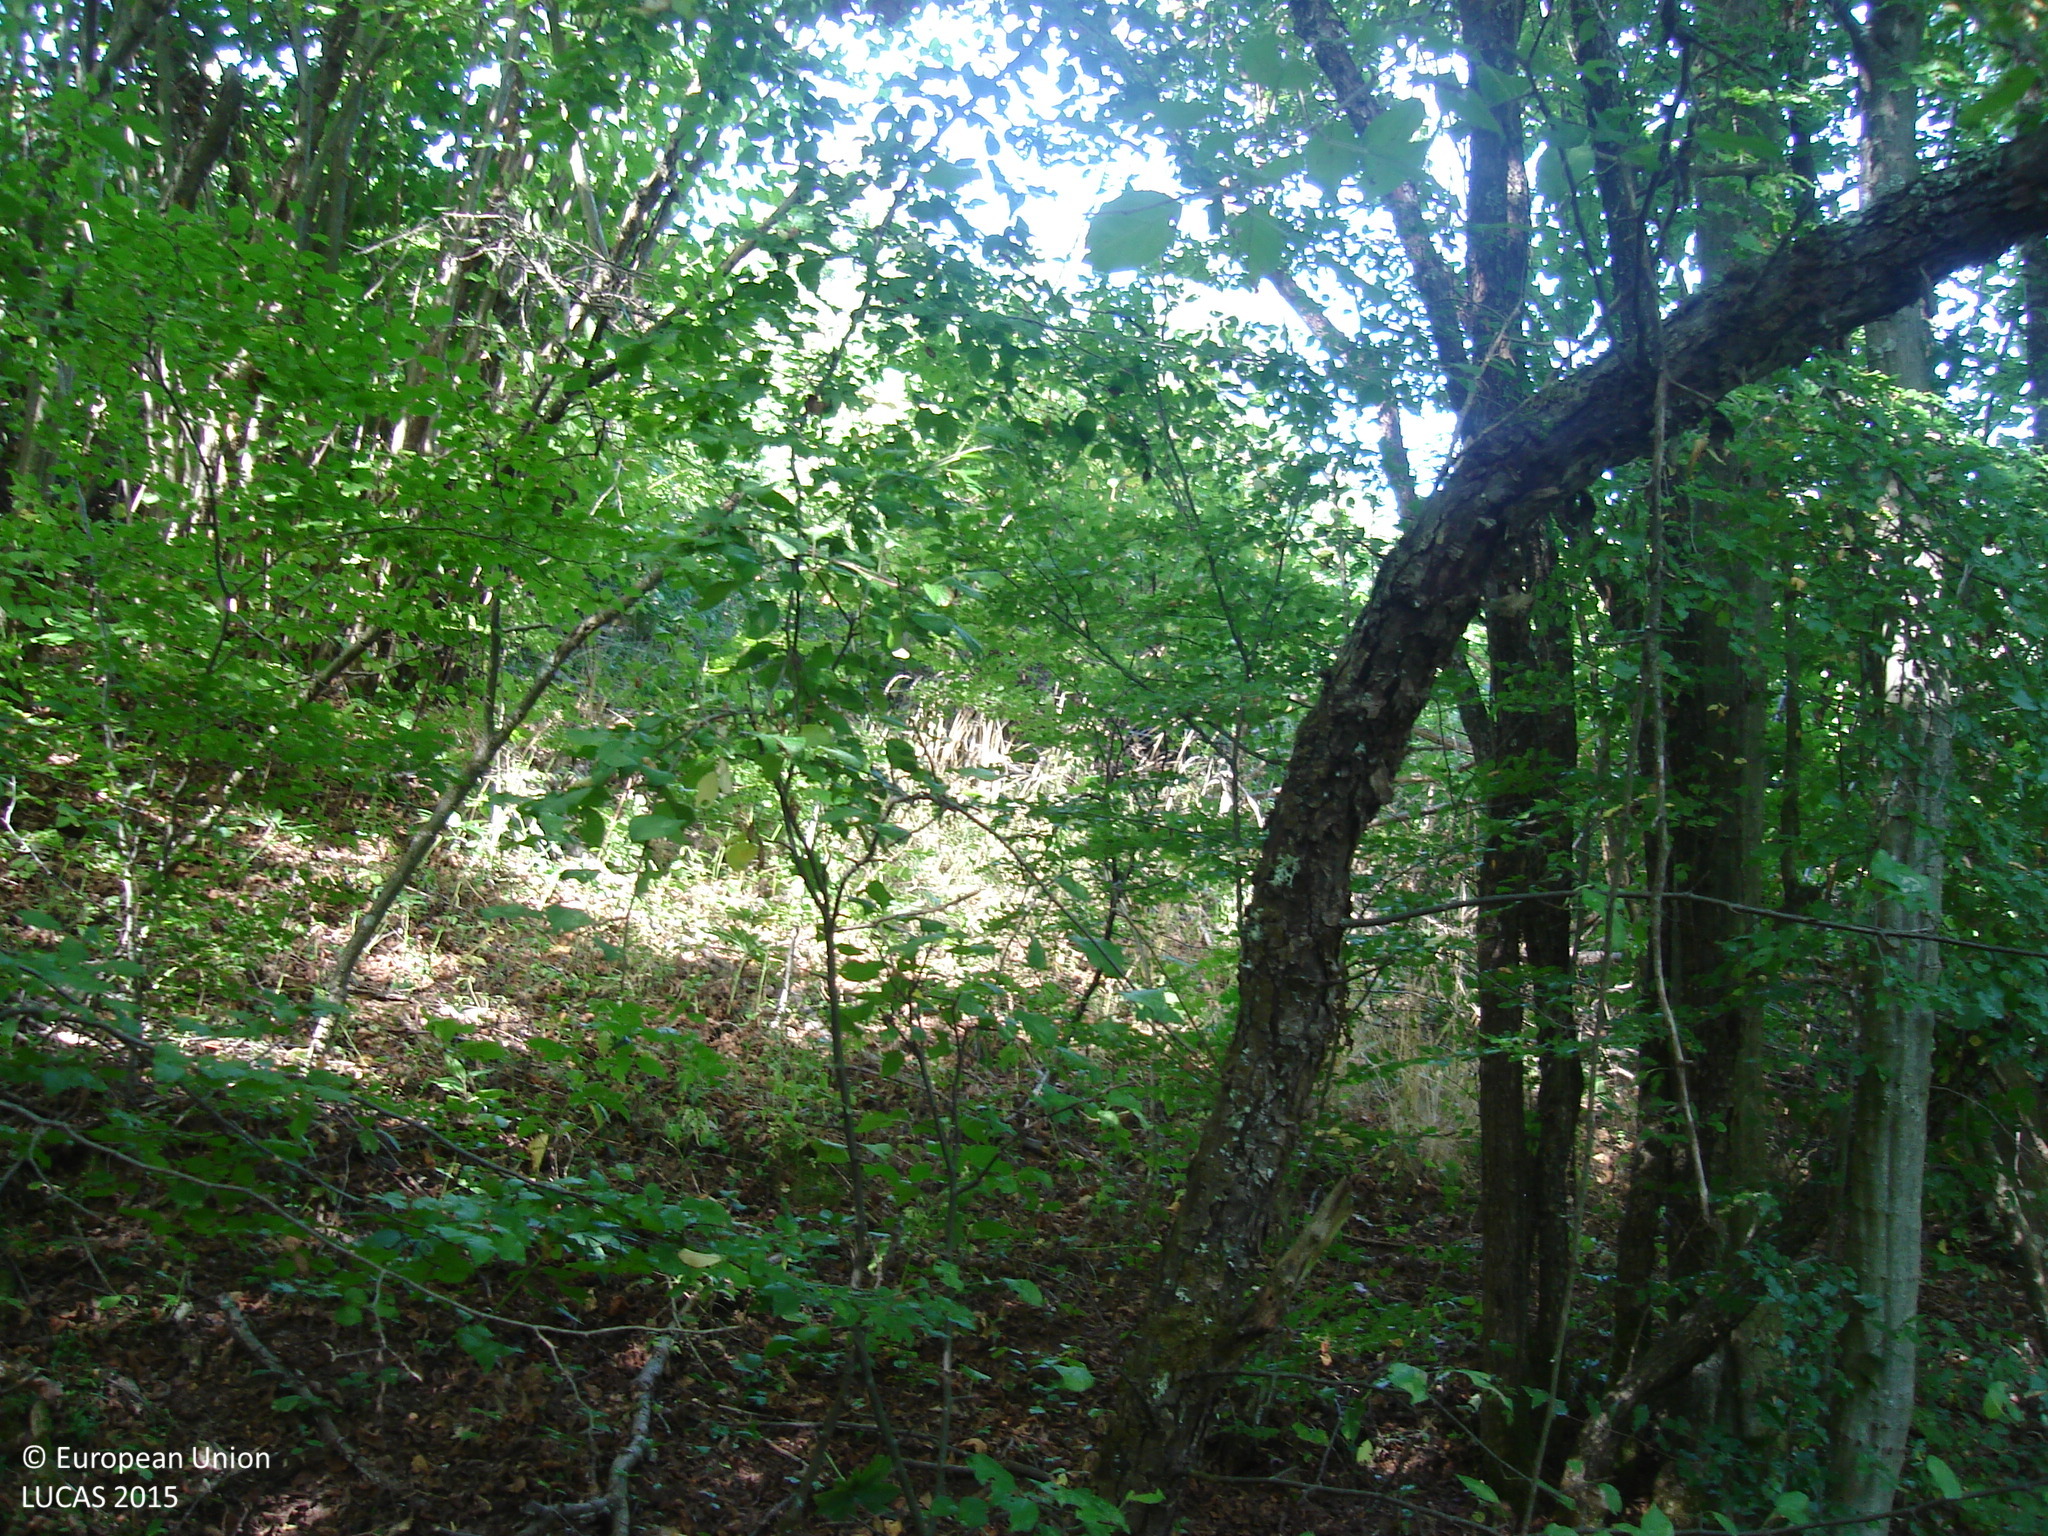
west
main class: Woodland
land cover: Broadleaved woodland
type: thermophilous deciduous forest
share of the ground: > 75 %
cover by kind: broadleaved forest trees 95 %, herbaceous plants 5 %
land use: Forestry
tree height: > 5 m
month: September
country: BG
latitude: 42.9840
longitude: 23.1194
